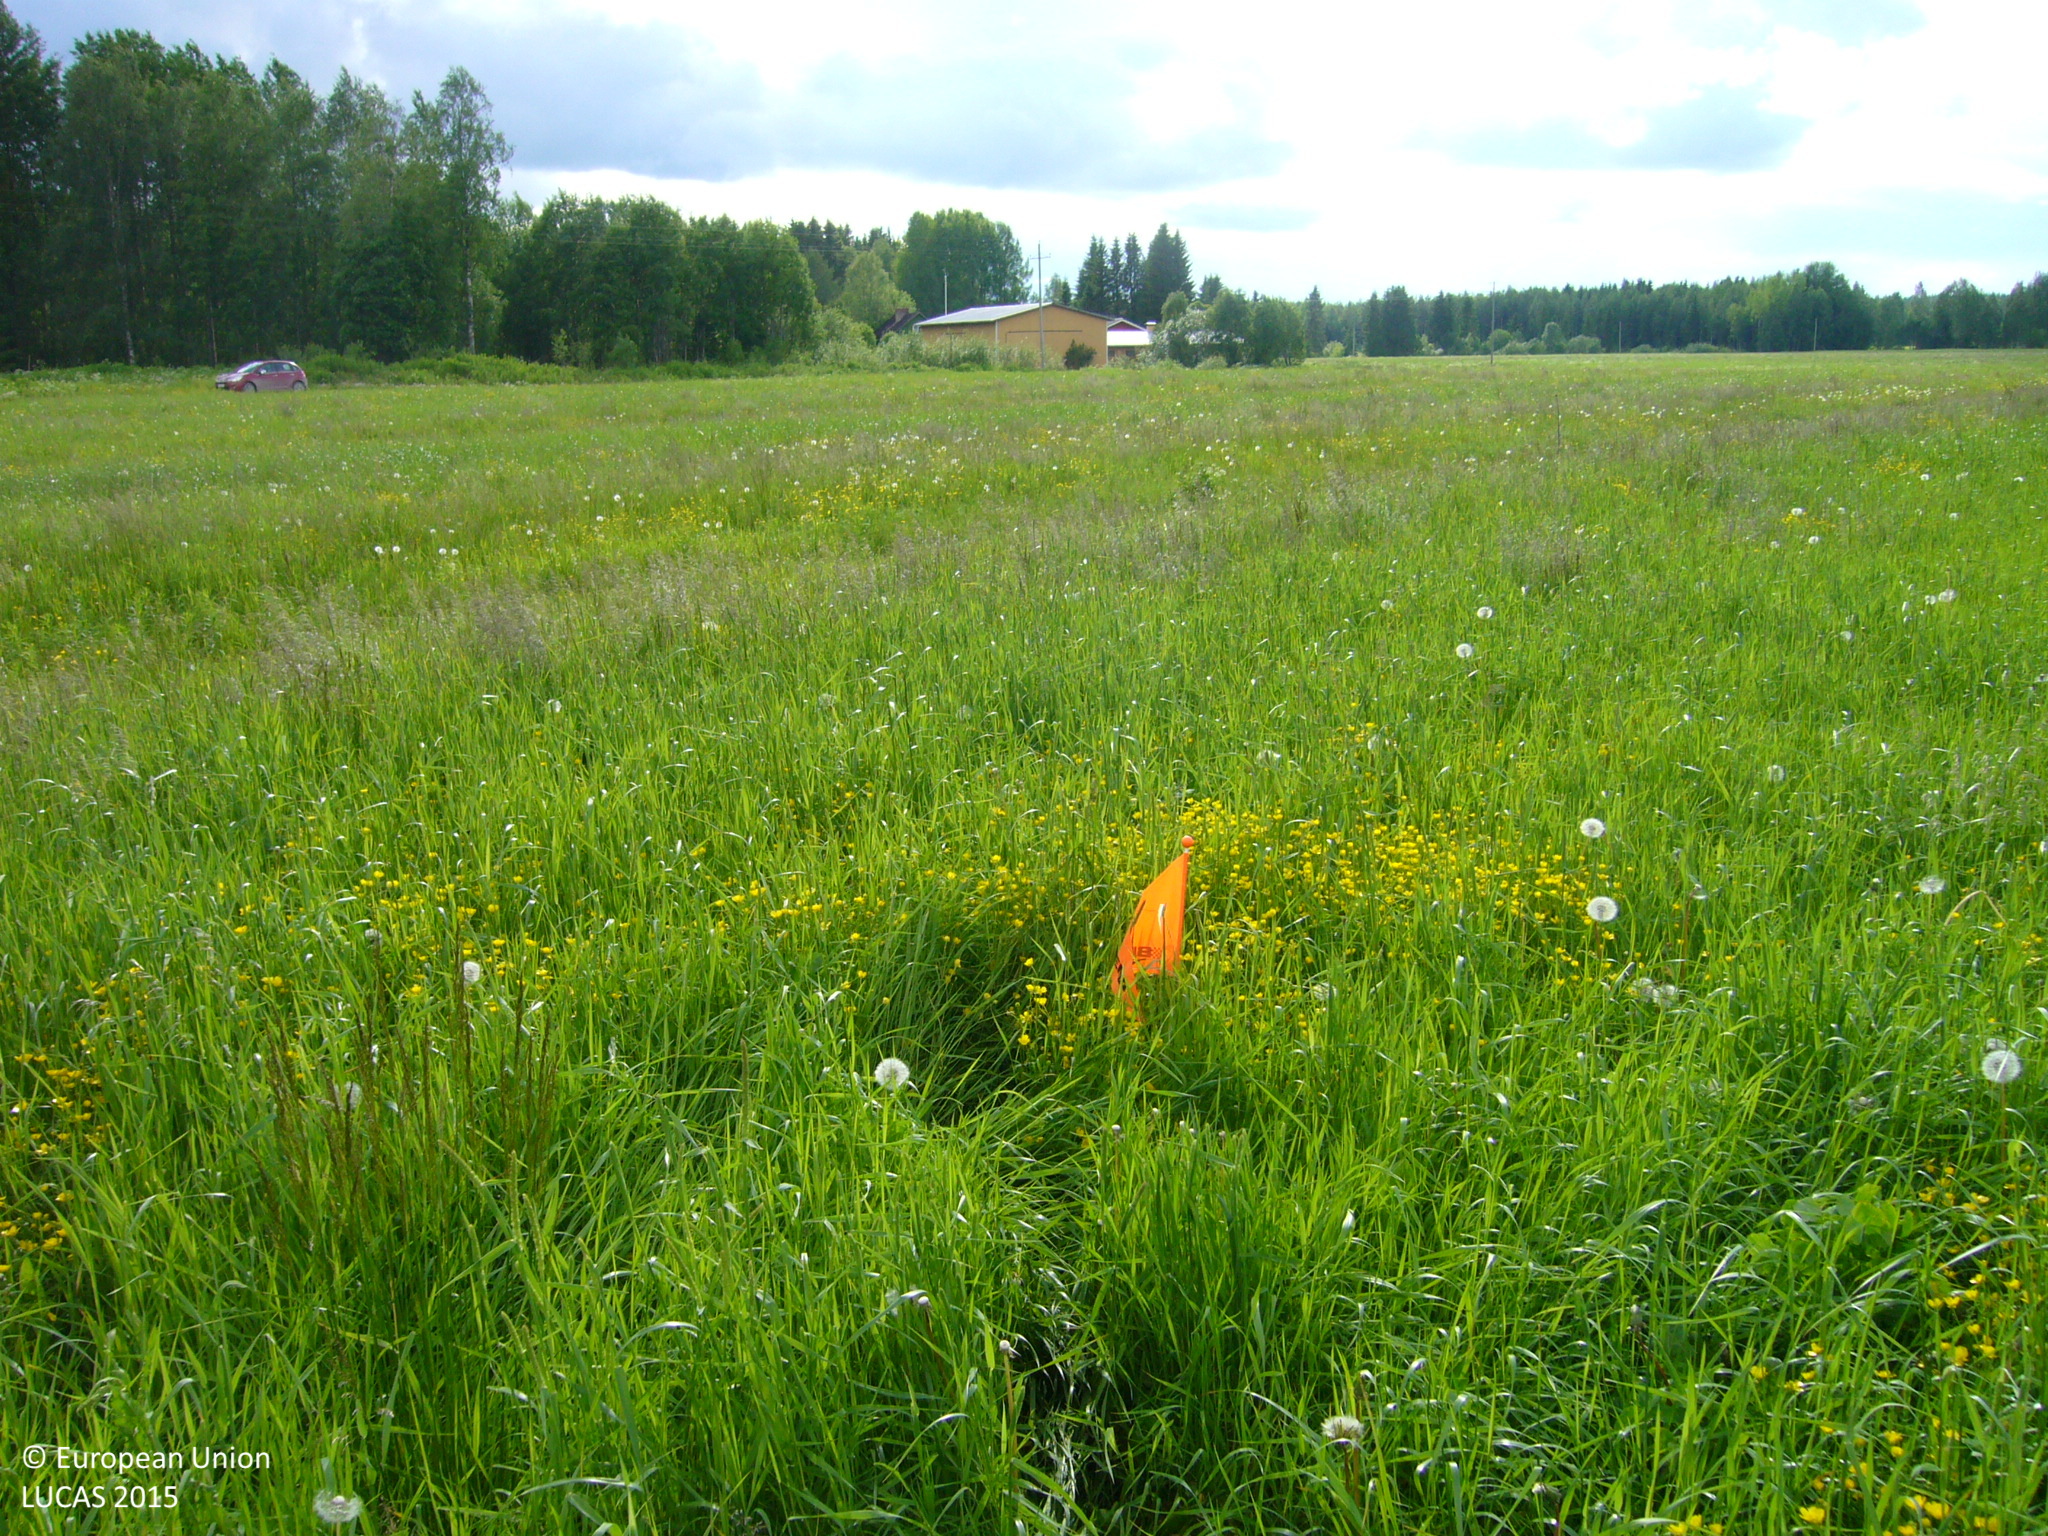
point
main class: Cropland
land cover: Temporary grasslands
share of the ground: > 75 %
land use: Agriculture (excluding fallow land and kitchen gardens)
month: June
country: FI
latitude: 63.7318
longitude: 26.3000
